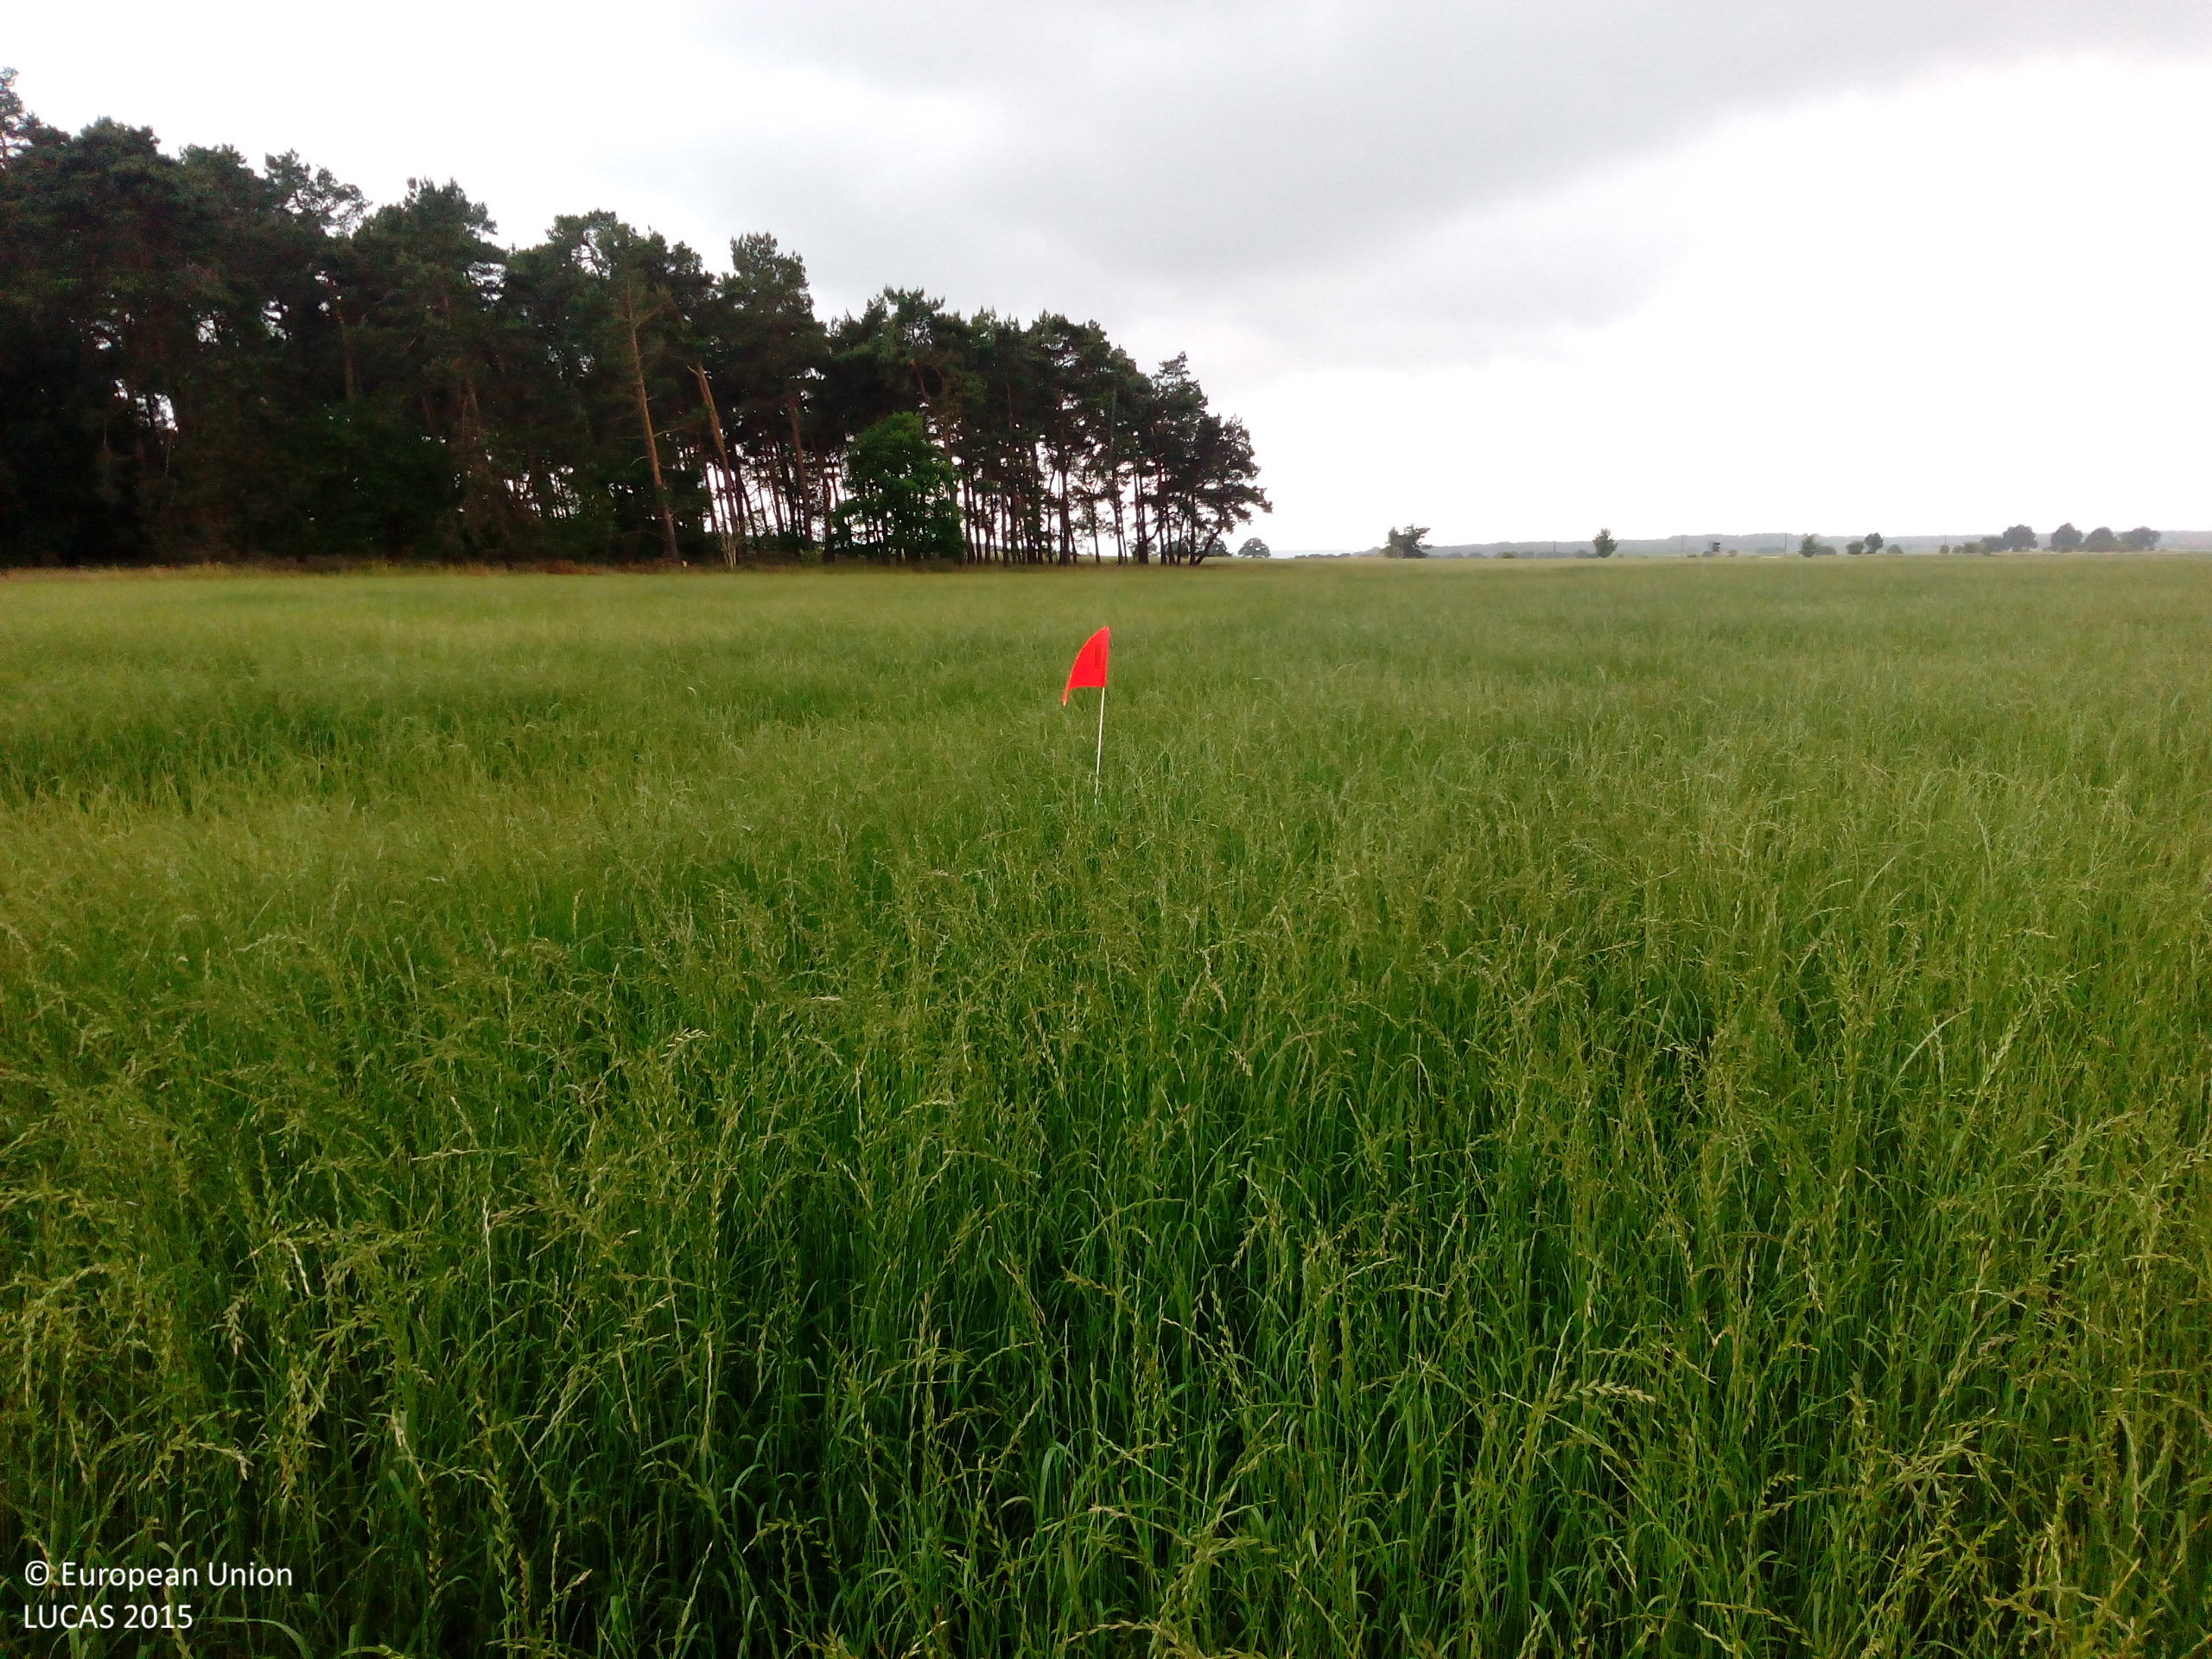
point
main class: Cropland
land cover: Temporary grasslands
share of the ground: > 75 %
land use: Agriculture (excluding fallow land and kitchen gardens)
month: June
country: DE
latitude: 52.3721
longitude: 11.1306
